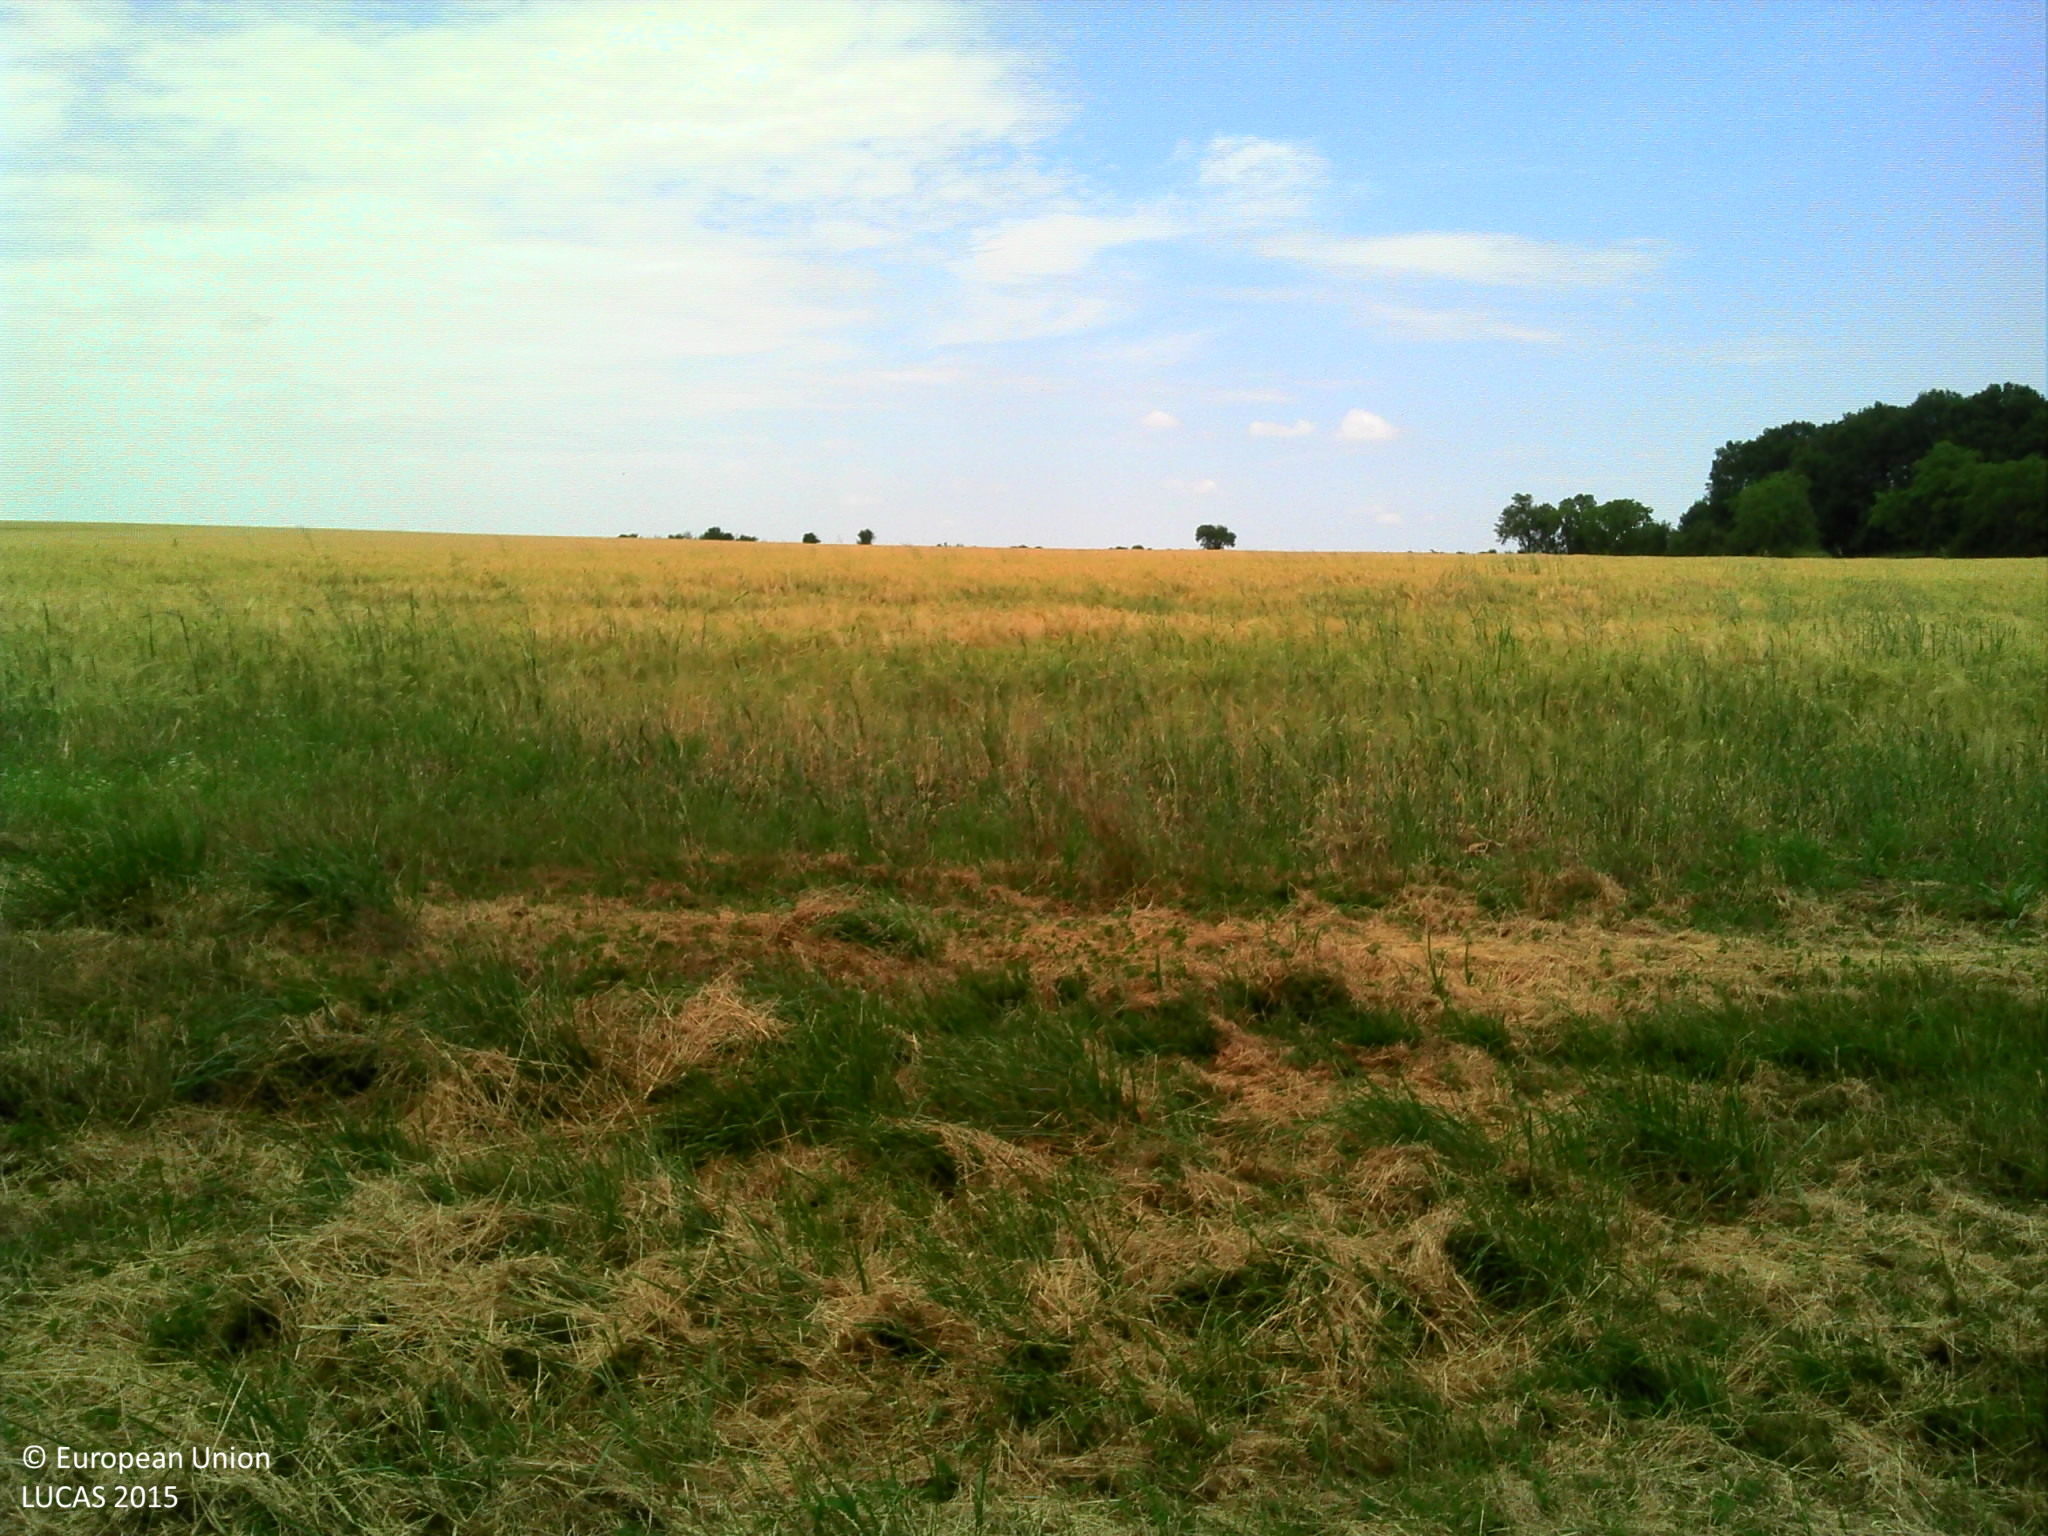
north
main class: Grassland
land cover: Grassland without tree/shrub cover
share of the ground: > 75 %
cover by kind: herbaceous plants 100 %
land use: Agriculture (excluding fallow land and kitchen gardens)
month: June
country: FR
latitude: 46.8387
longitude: 2.6389
